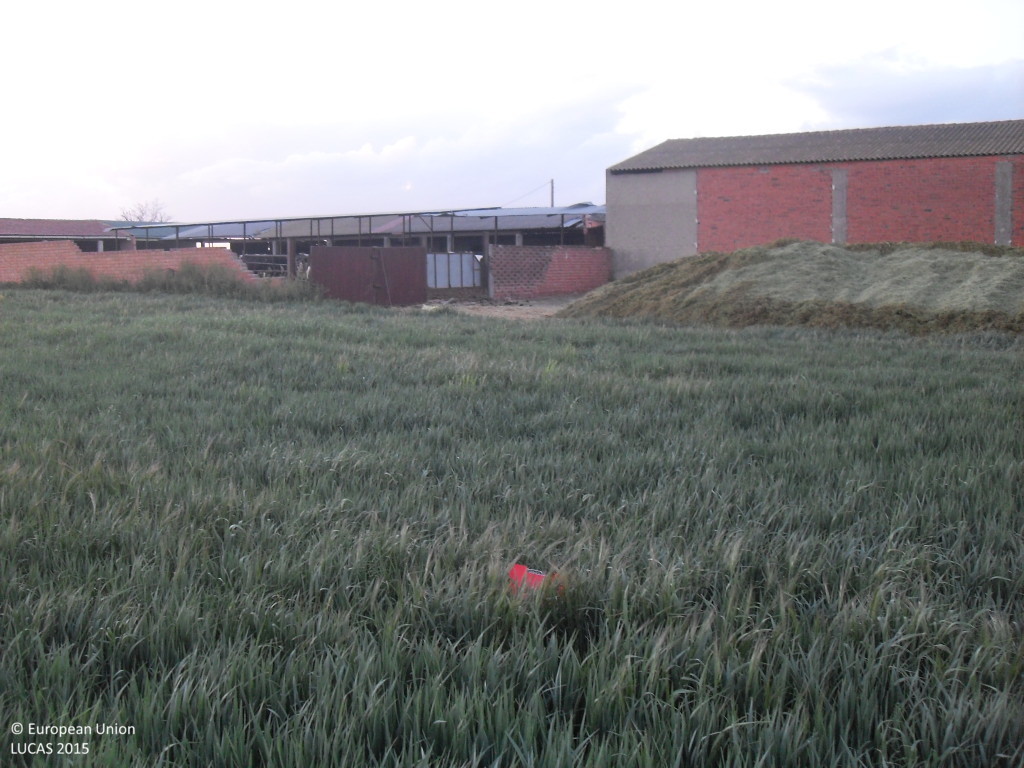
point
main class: Cropland
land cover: Oats
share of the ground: > 75 %
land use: Agriculture (excluding fallow land and kitchen gardens)
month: April
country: ES
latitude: 40.8544
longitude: -5.2155
